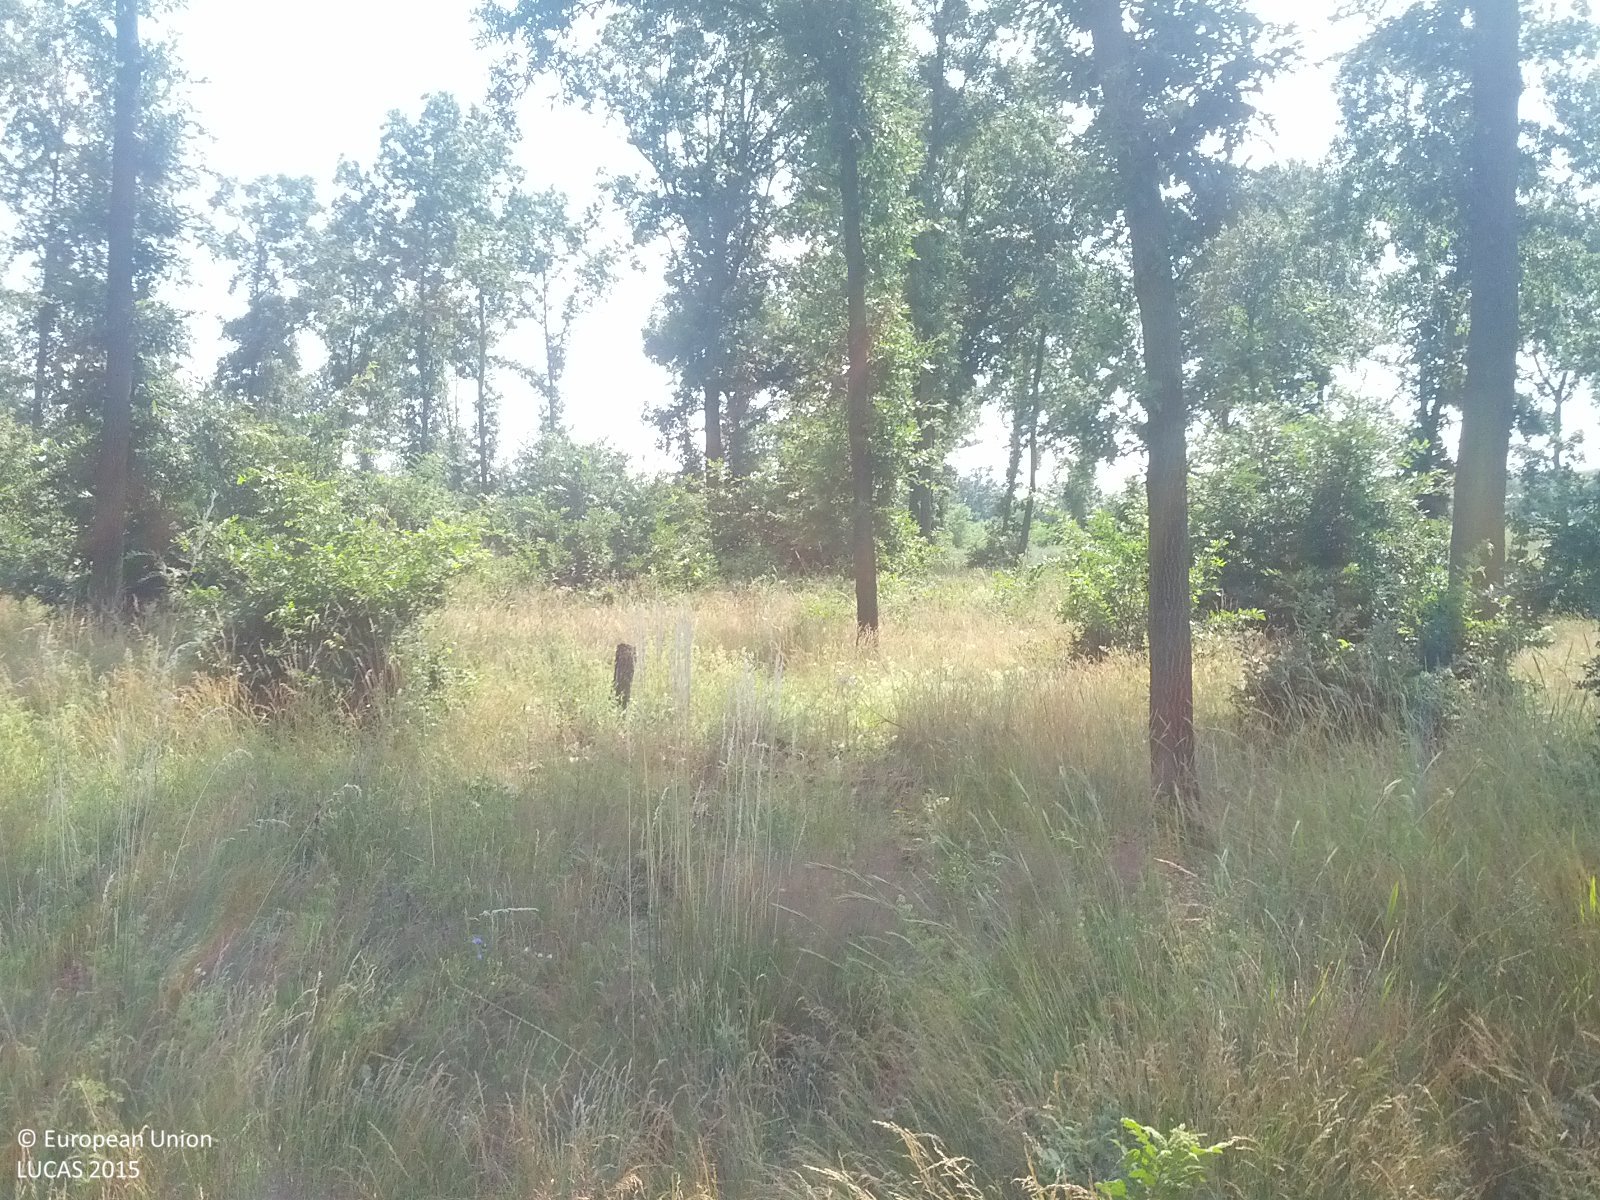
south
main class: Woodland
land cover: Broadleaved woodland
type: thermophilous deciduous forest
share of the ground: 25 - 50 %
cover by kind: herbaceous plants 65 %, broadleaved forest trees 30 %, shrubs 5 %
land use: Forestry
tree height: > 5 m
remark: Clear cut
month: July
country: AT
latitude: 48.5442
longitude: 16.6848
